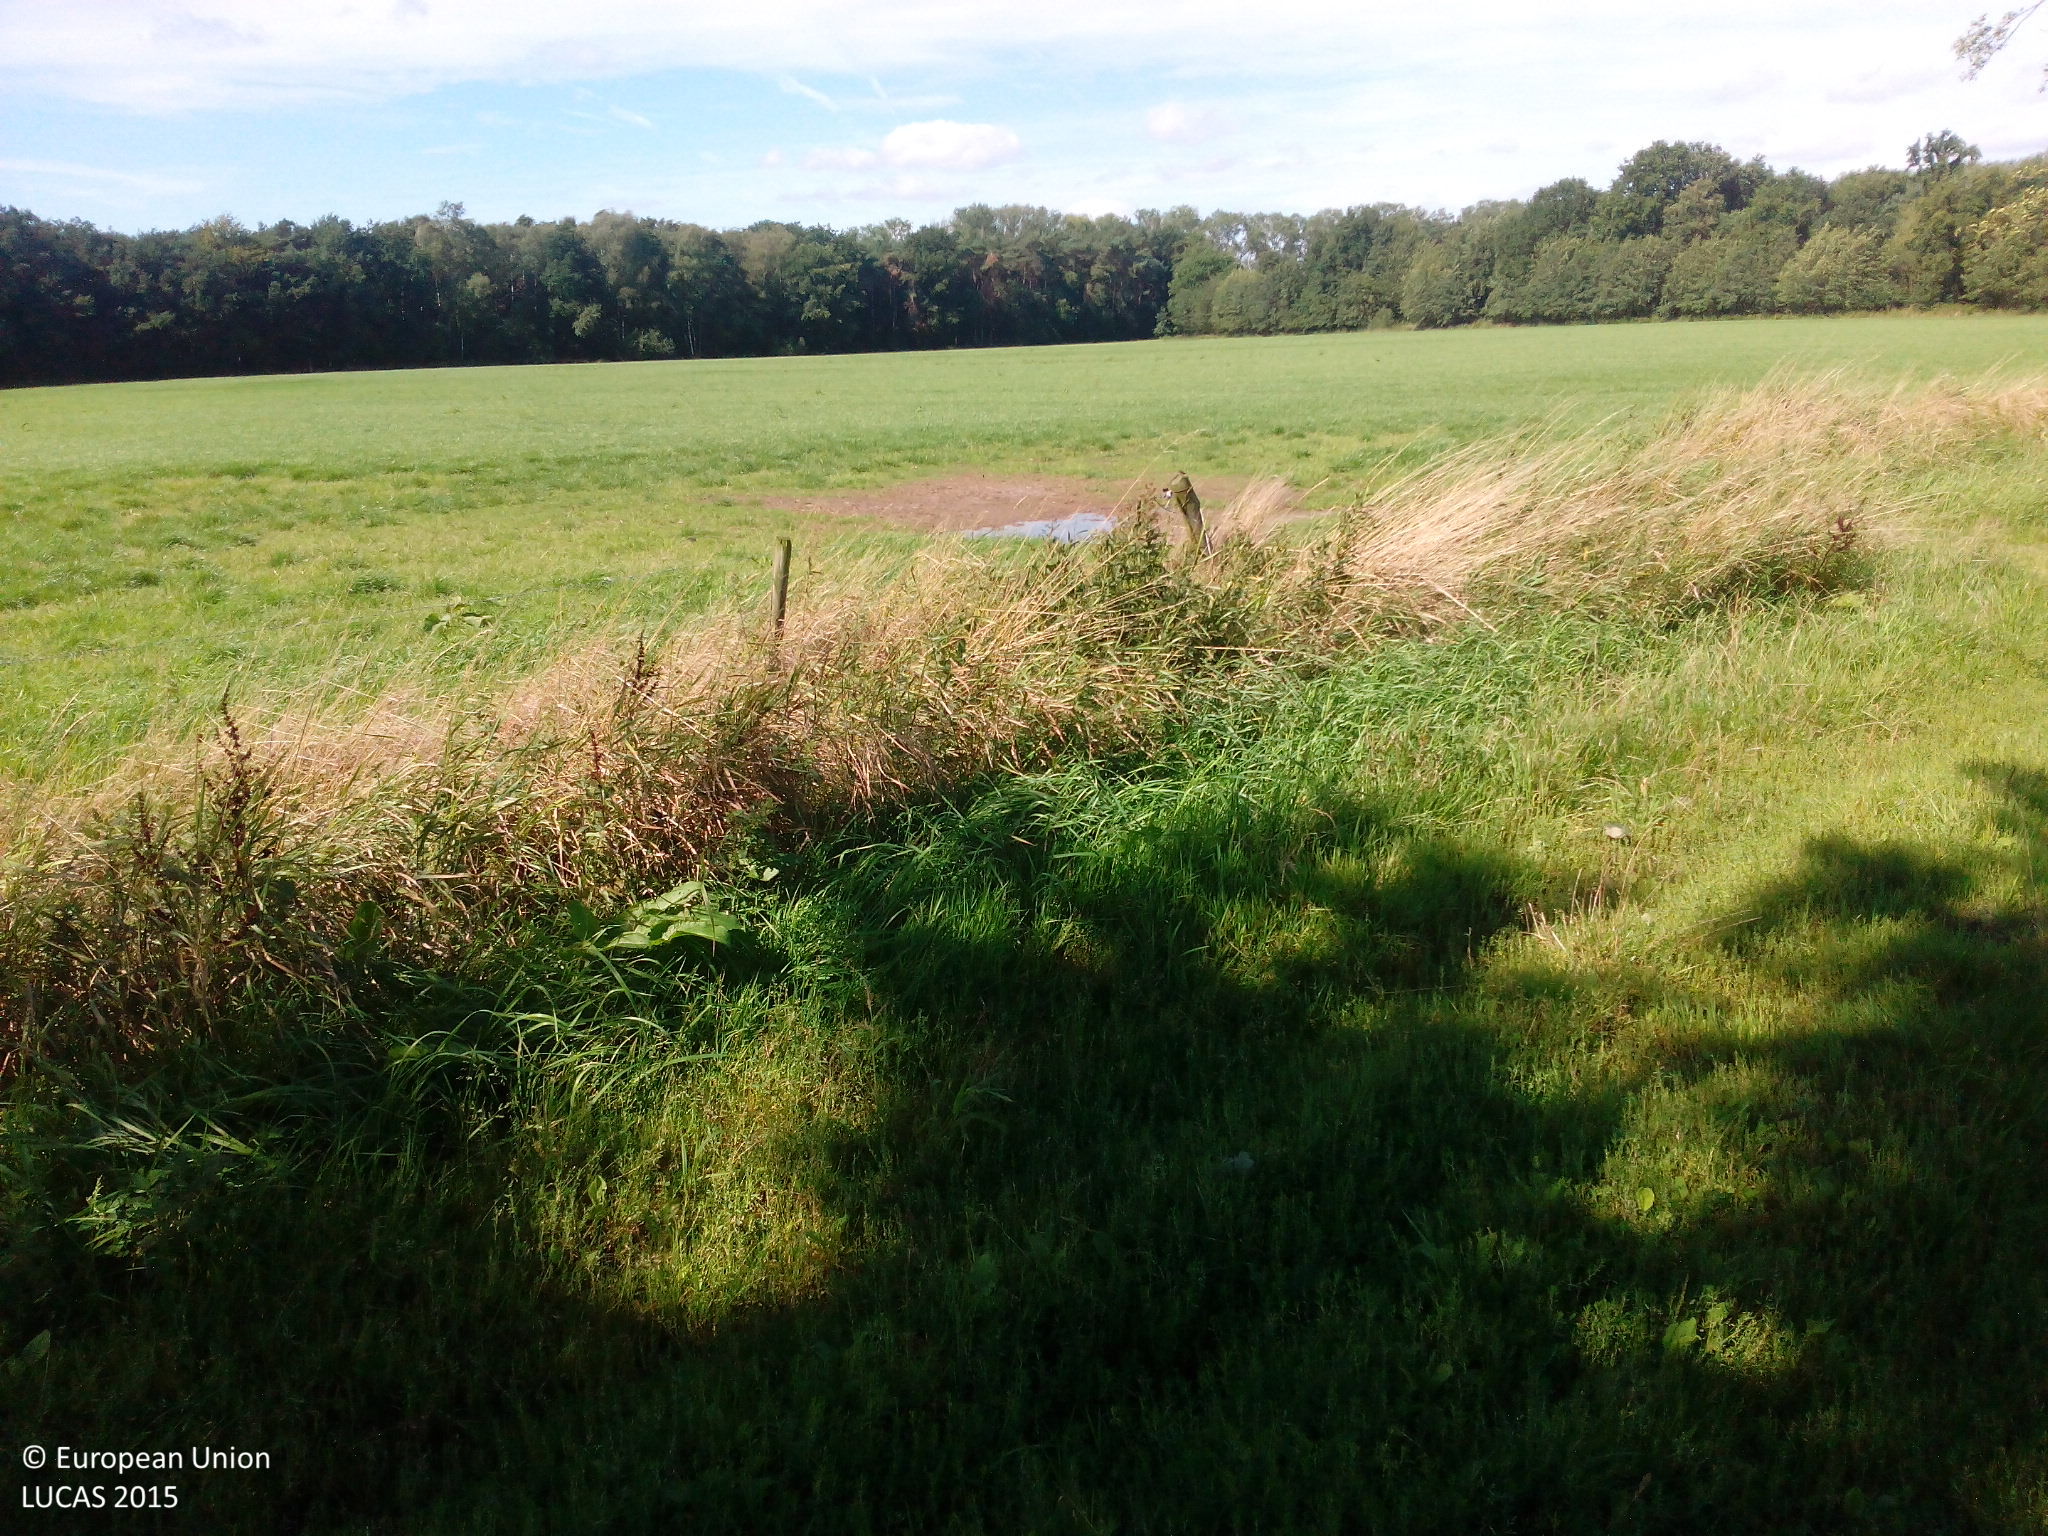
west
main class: Cropland
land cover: Maize
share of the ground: > 75 %
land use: Agriculture (excluding fallow land and kitchen gardens)
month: August
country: NL
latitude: 51.3099
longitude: 5.7091
